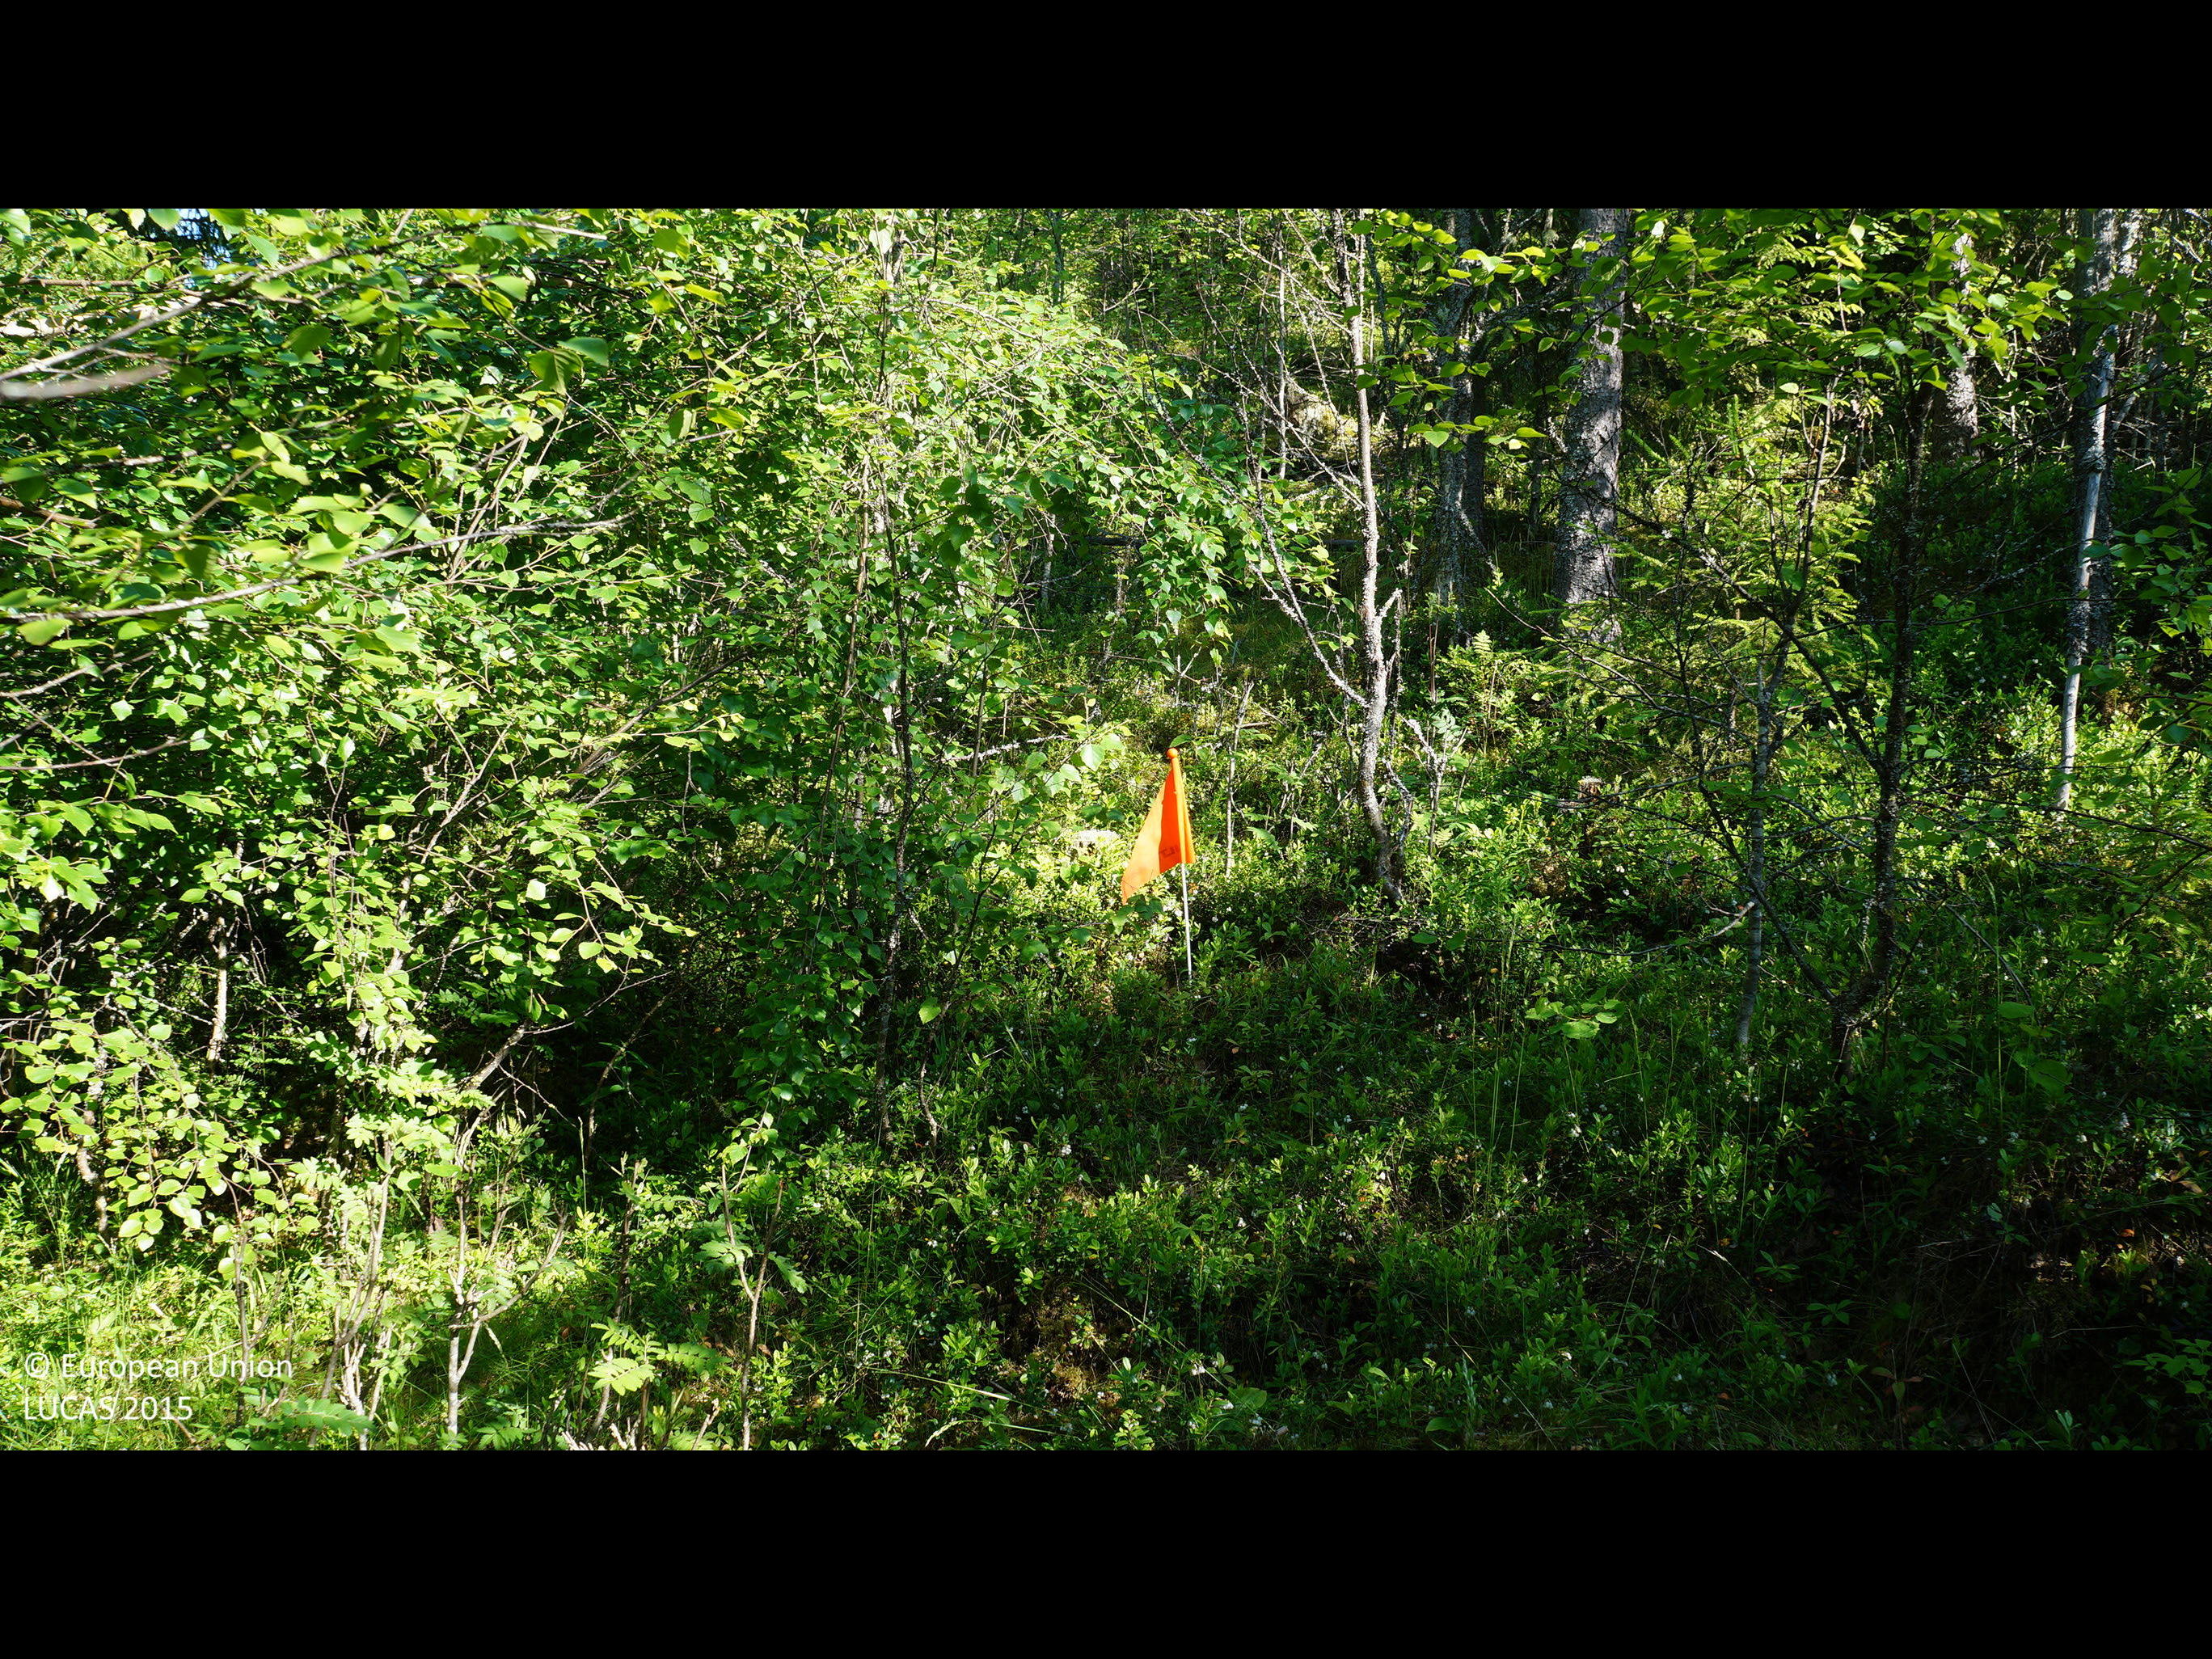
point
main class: Woodland
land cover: Broadleaved woodland
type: boreal forest
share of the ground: 50 - 75 %
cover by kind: broadleaved forest trees 50 %, shrubs 45 %, coniferous forest trees 5 %
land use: Forestry
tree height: > 5 m
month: July
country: FI
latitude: 63.6942
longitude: 23.0170
